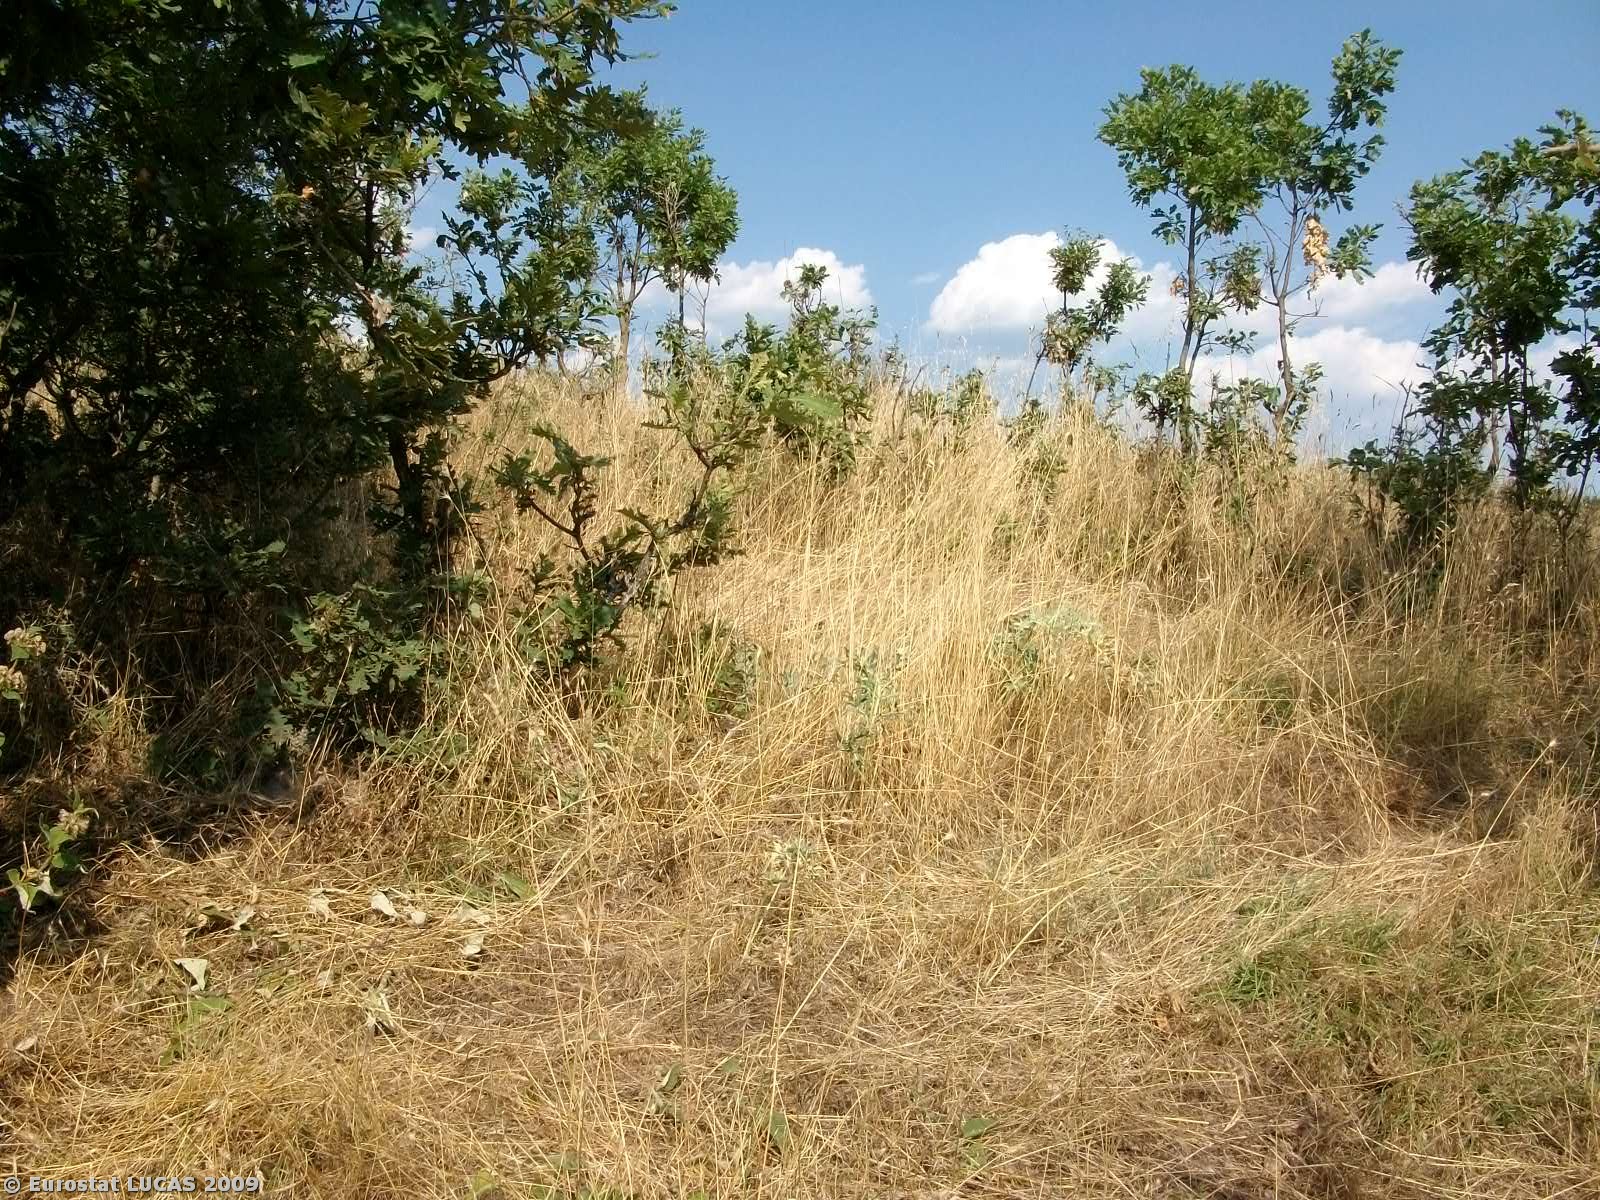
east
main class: Woodland
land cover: Broadleaved woodland
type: thermophilous deciduous forest
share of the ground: 50 - 75 %
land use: Forestry
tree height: > 5 m
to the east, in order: Broadleaved woodland; Grassland with sparse tree/shrub cover; Grassland without tree/shrub cover; Broadleaved woodland
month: July
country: GR
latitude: 39.7993
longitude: 21.7233
